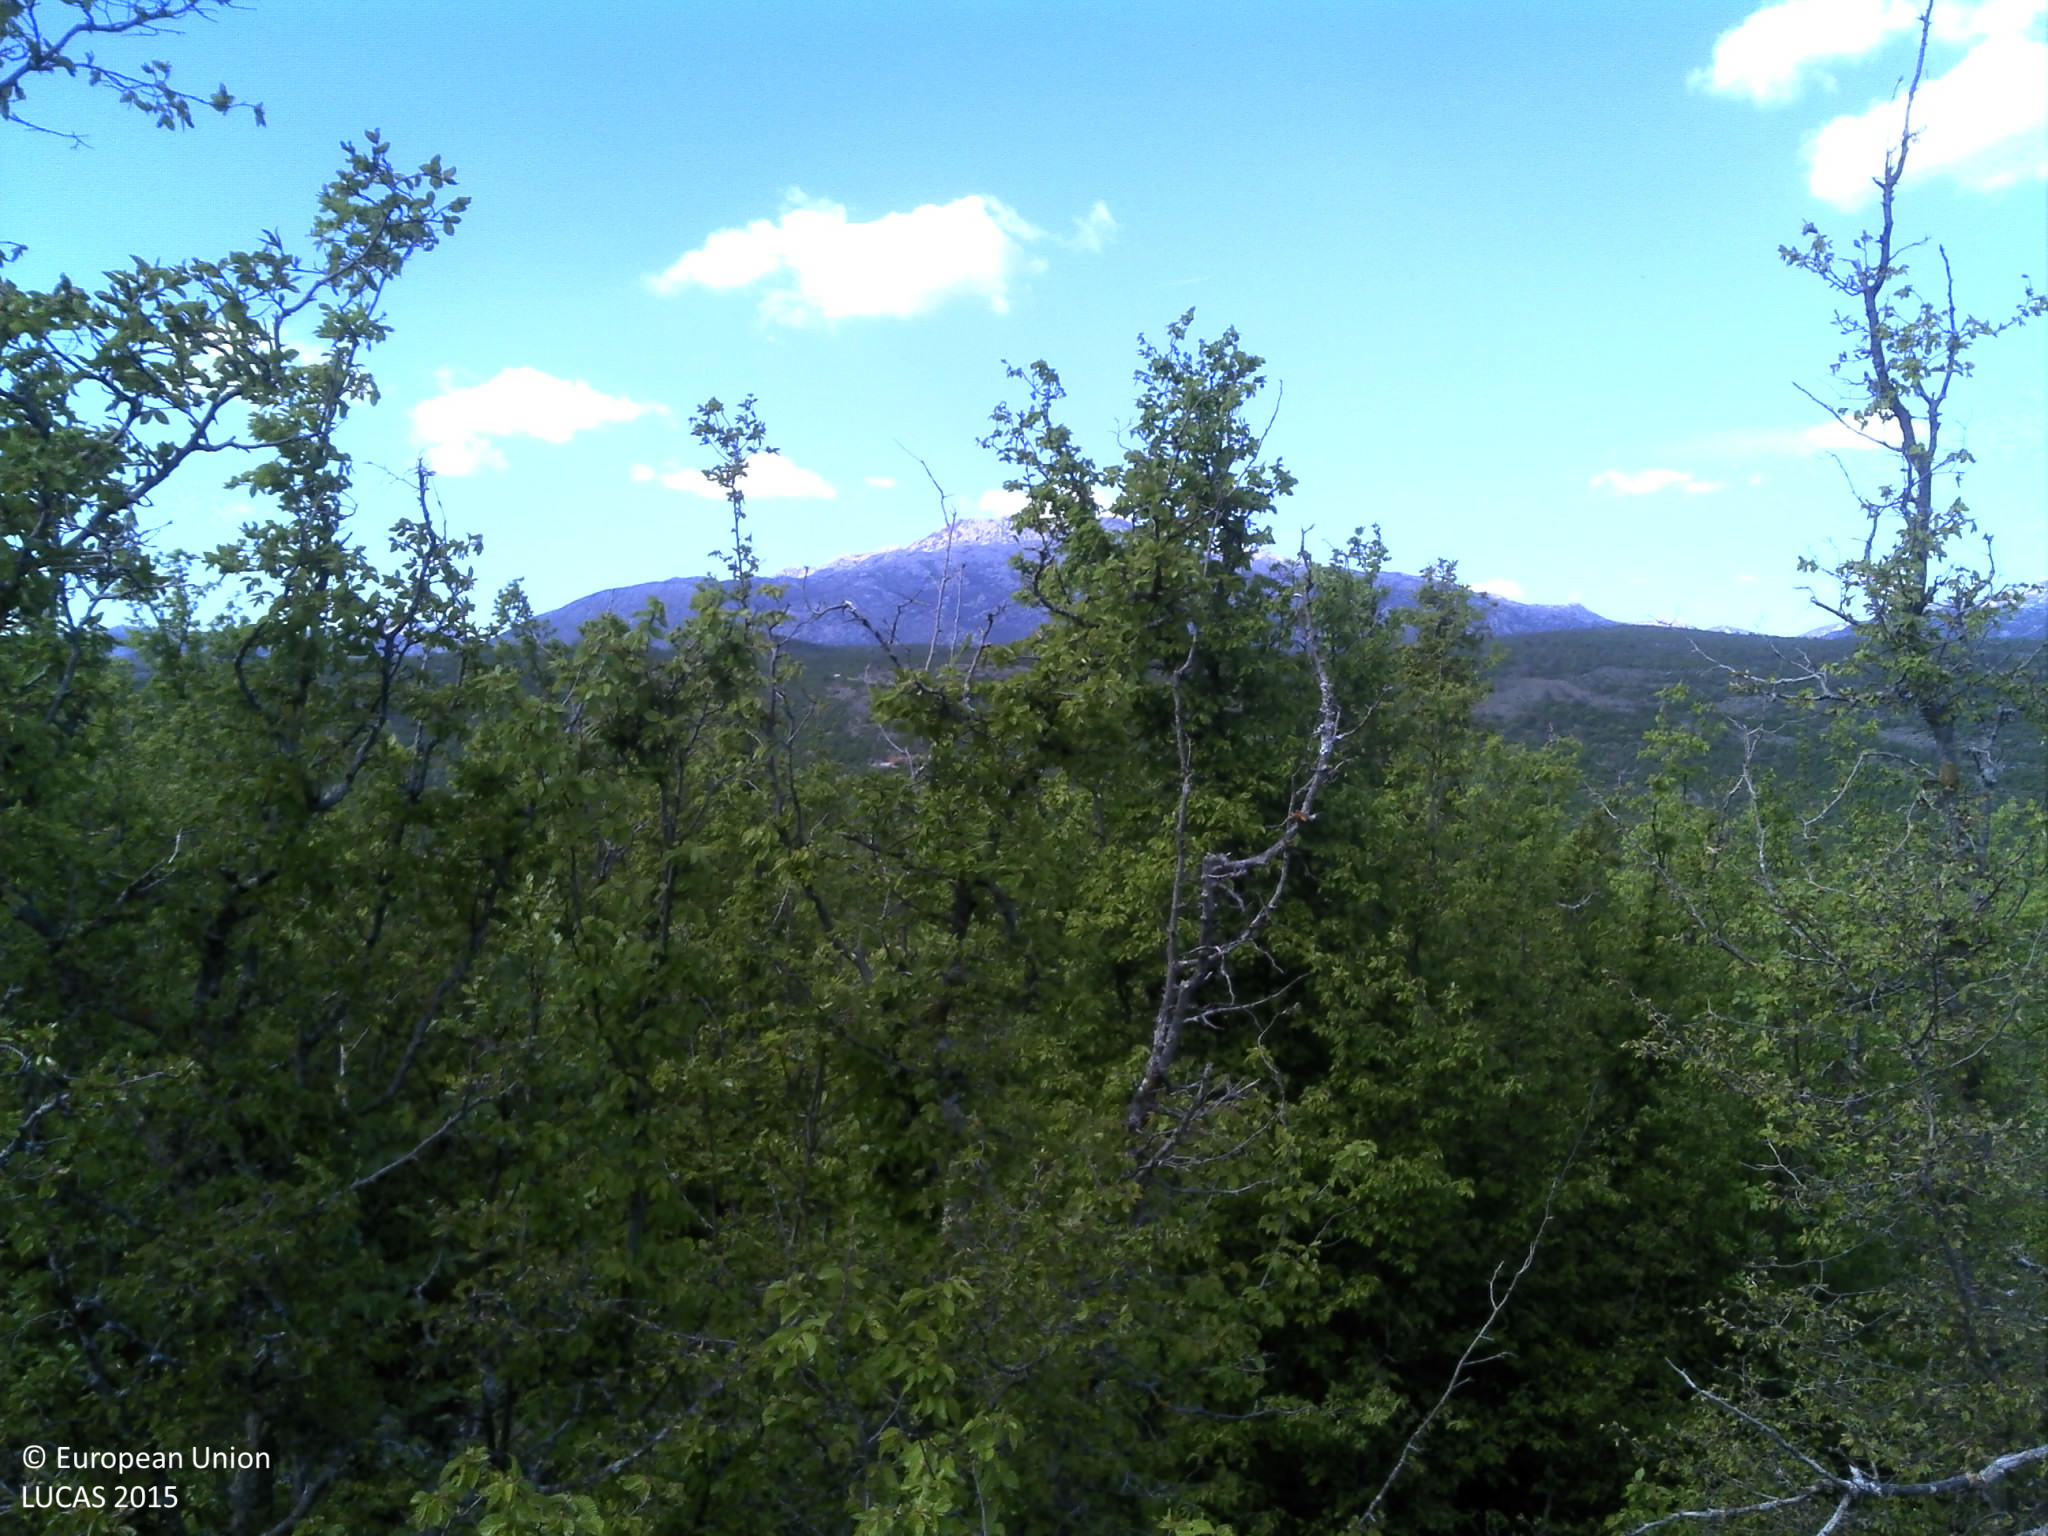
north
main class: Woodland
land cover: Broadleaved woodland
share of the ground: > 75 %
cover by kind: broadleaved forest trees 90 %, herbaceous plants 5 %, unconsolidated bare surface 5 %
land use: Semi-natural and natural areas not in use
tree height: < 5 m
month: April
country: HR
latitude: 44.1835
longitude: 15.8846
